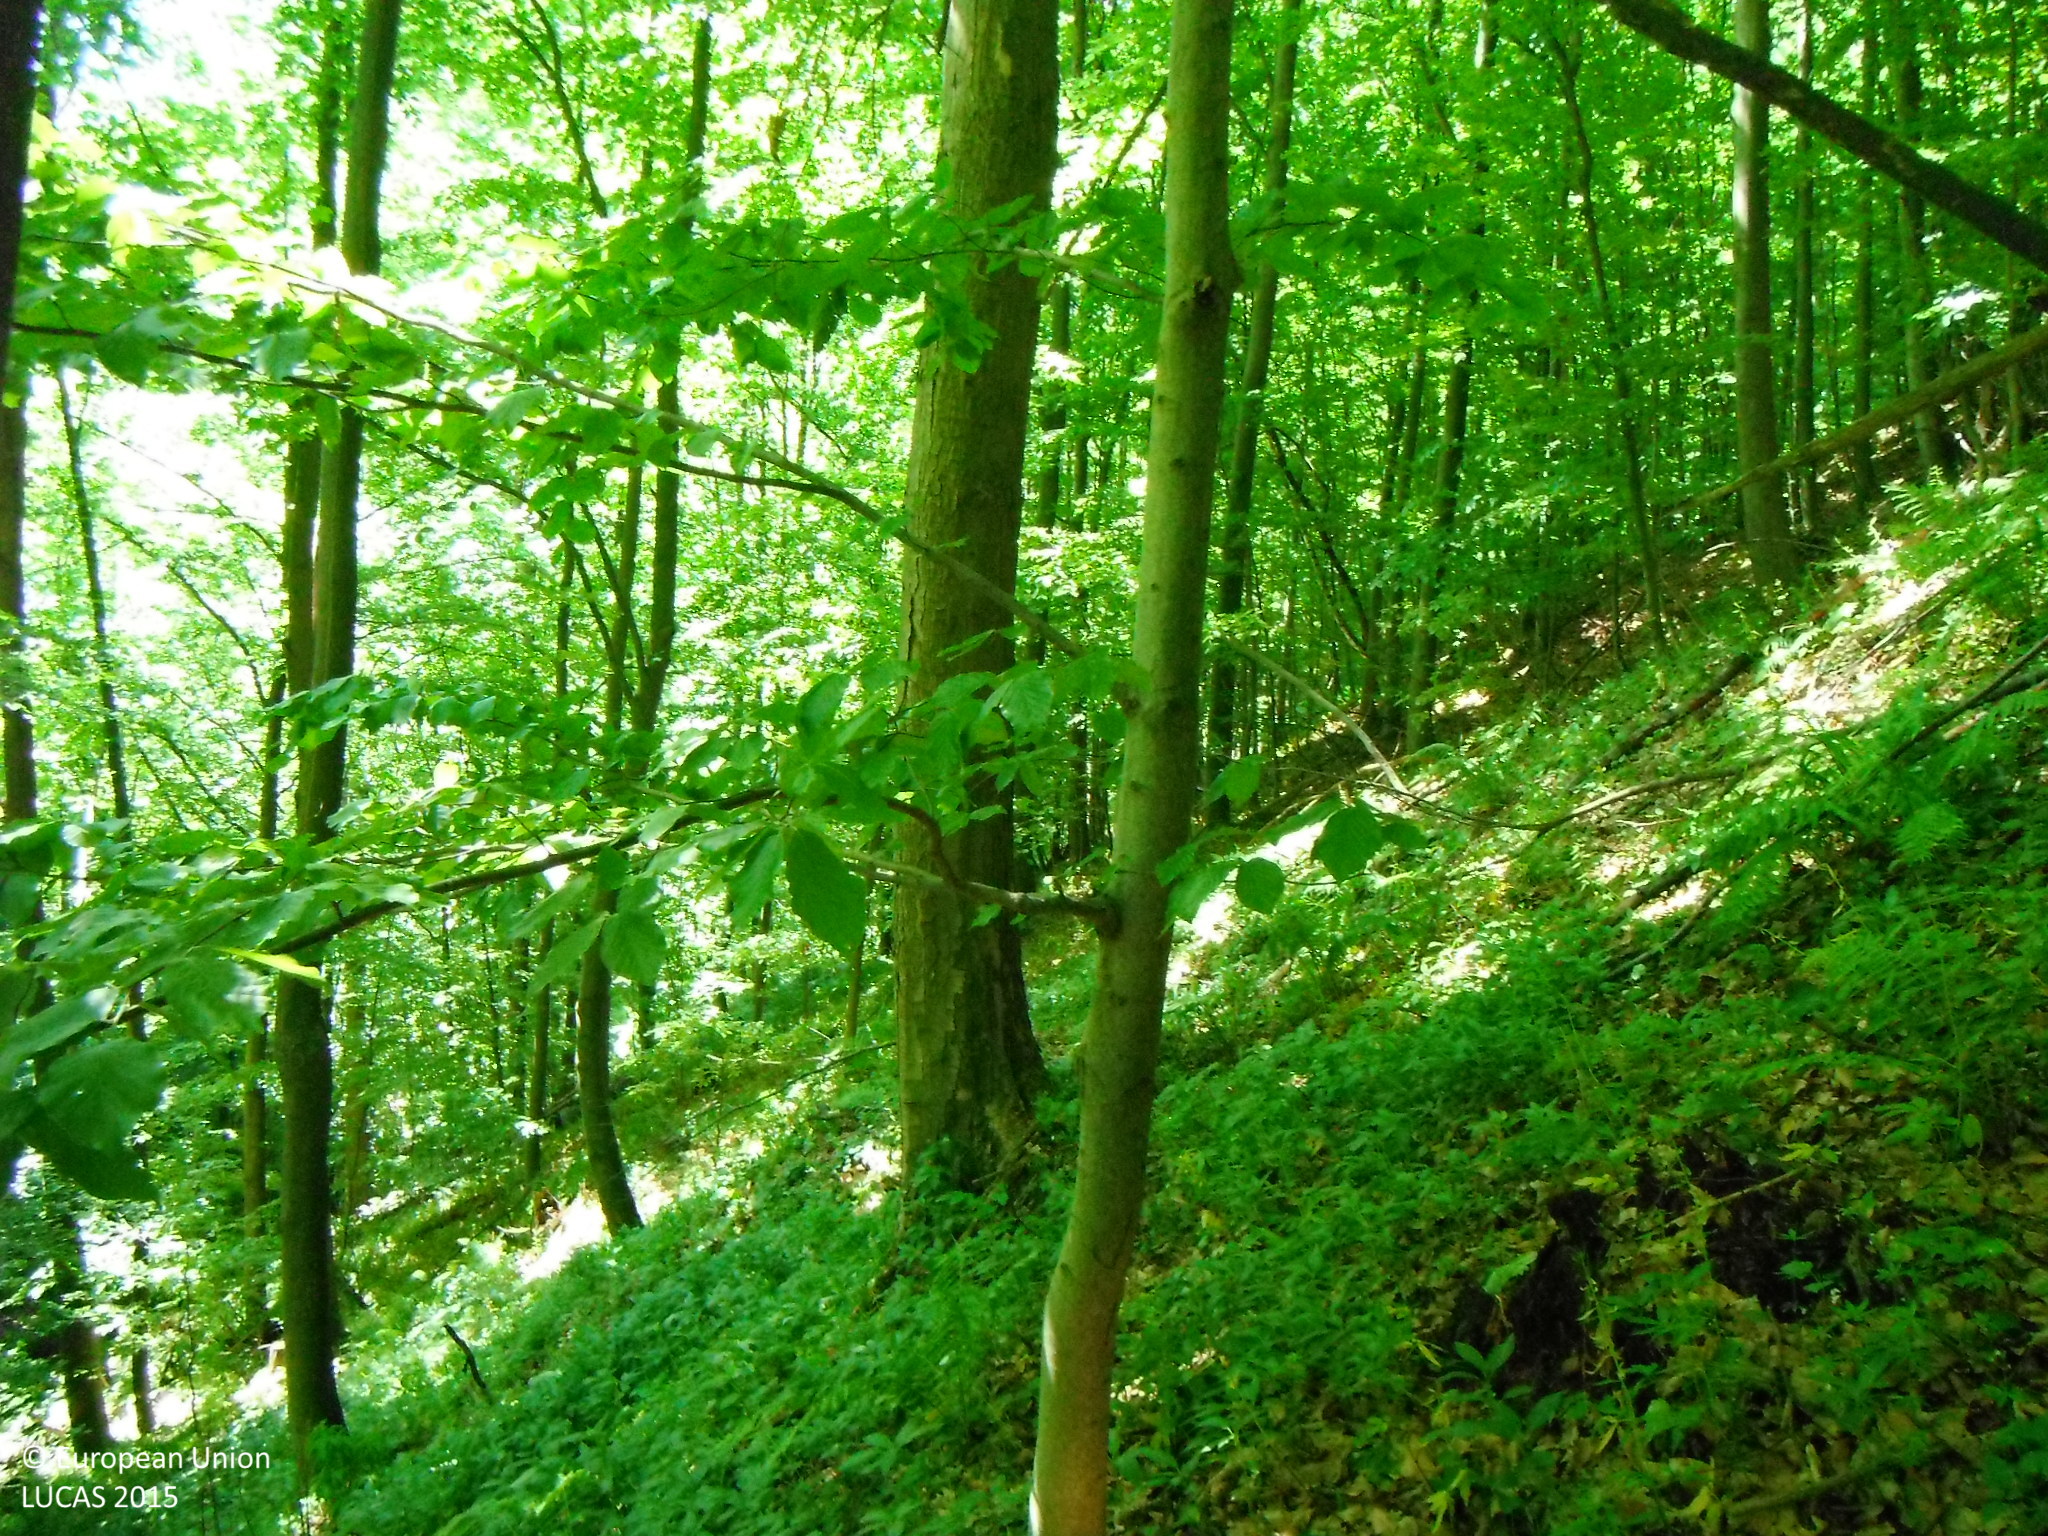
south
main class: Woodland
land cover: Broadleaved woodland
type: beech forest
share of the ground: > 75 %
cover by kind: broadleaved forest trees 95 %, herbaceous plants 5 %
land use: Forestry
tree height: > 5 m
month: May
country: SK
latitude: 48.5688
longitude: 19.5526
